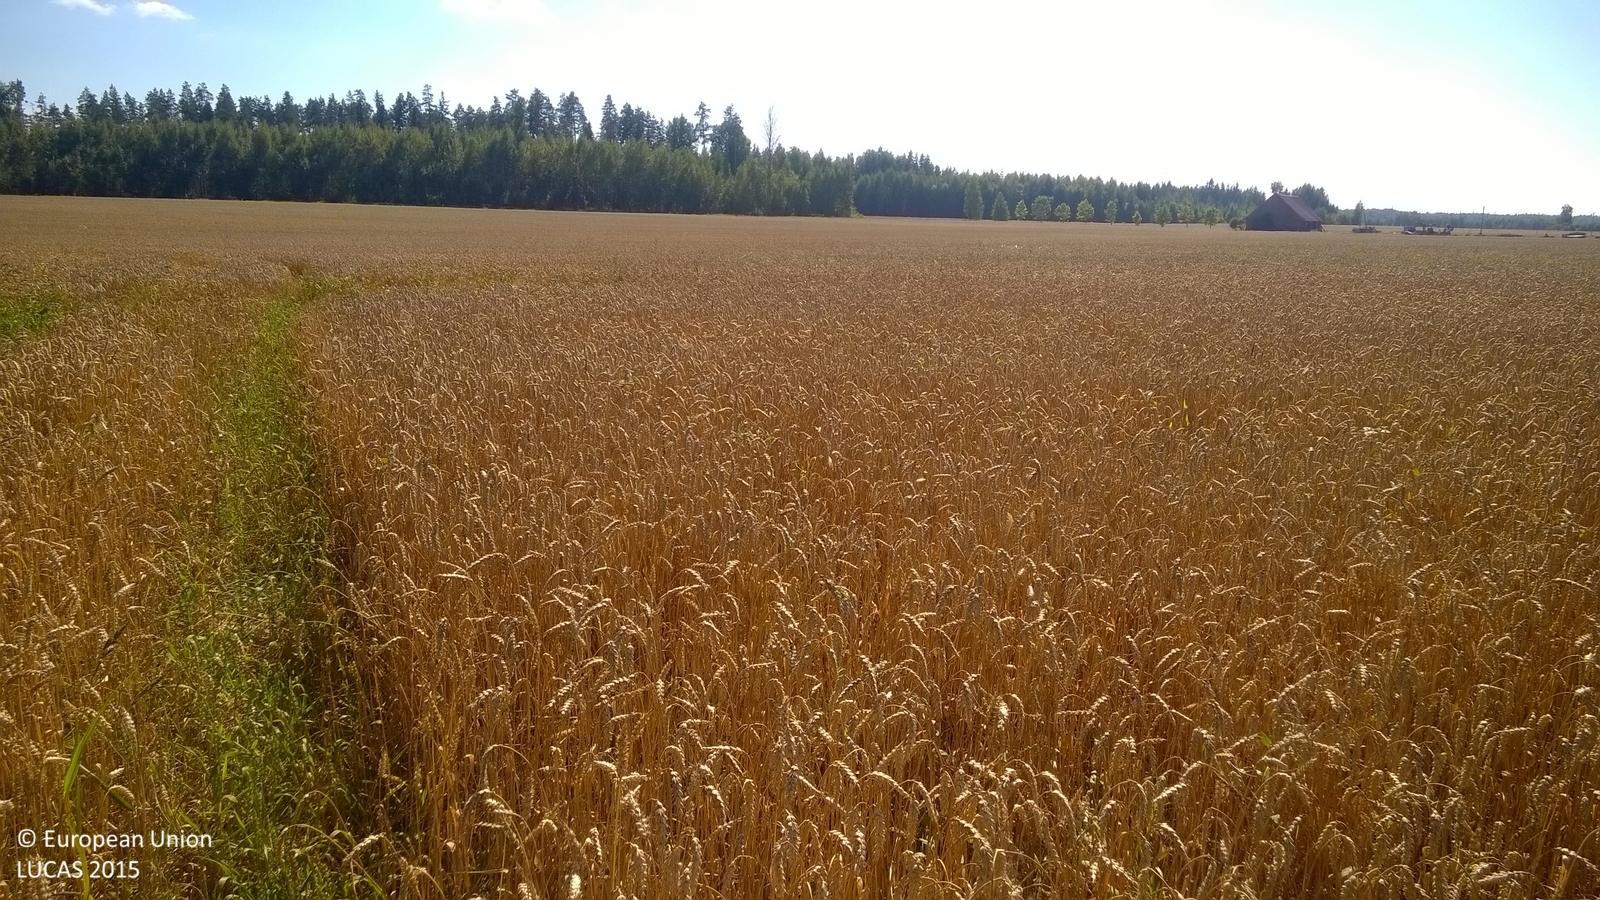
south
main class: Cropland
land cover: Common wheat
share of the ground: > 75 %
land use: Agriculture (excluding fallow land and kitchen gardens)
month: August
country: LV
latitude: 57.5476
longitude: 25.9844
